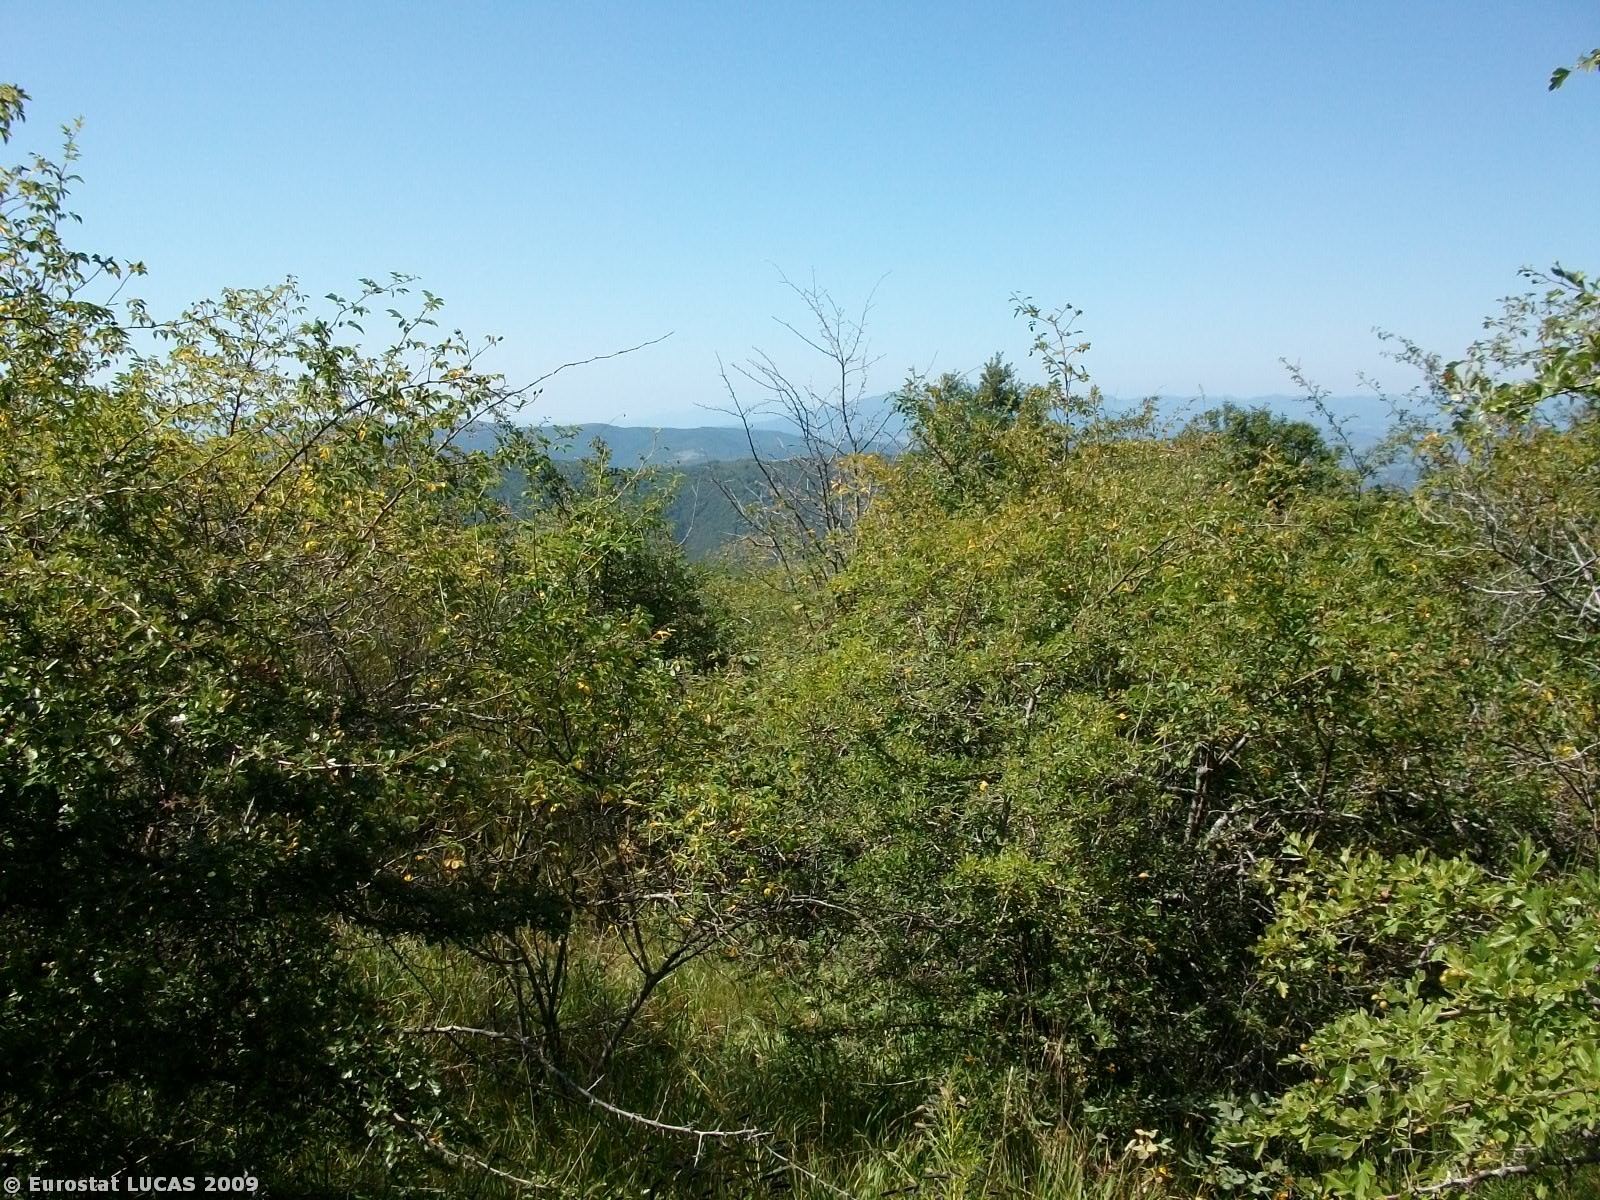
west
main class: Shrubland
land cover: Shrubland with sparse tree cover
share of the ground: > 75 %
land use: Nature reserves
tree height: > 5 m
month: July
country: IT
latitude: 43.4097
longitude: 12.0566
